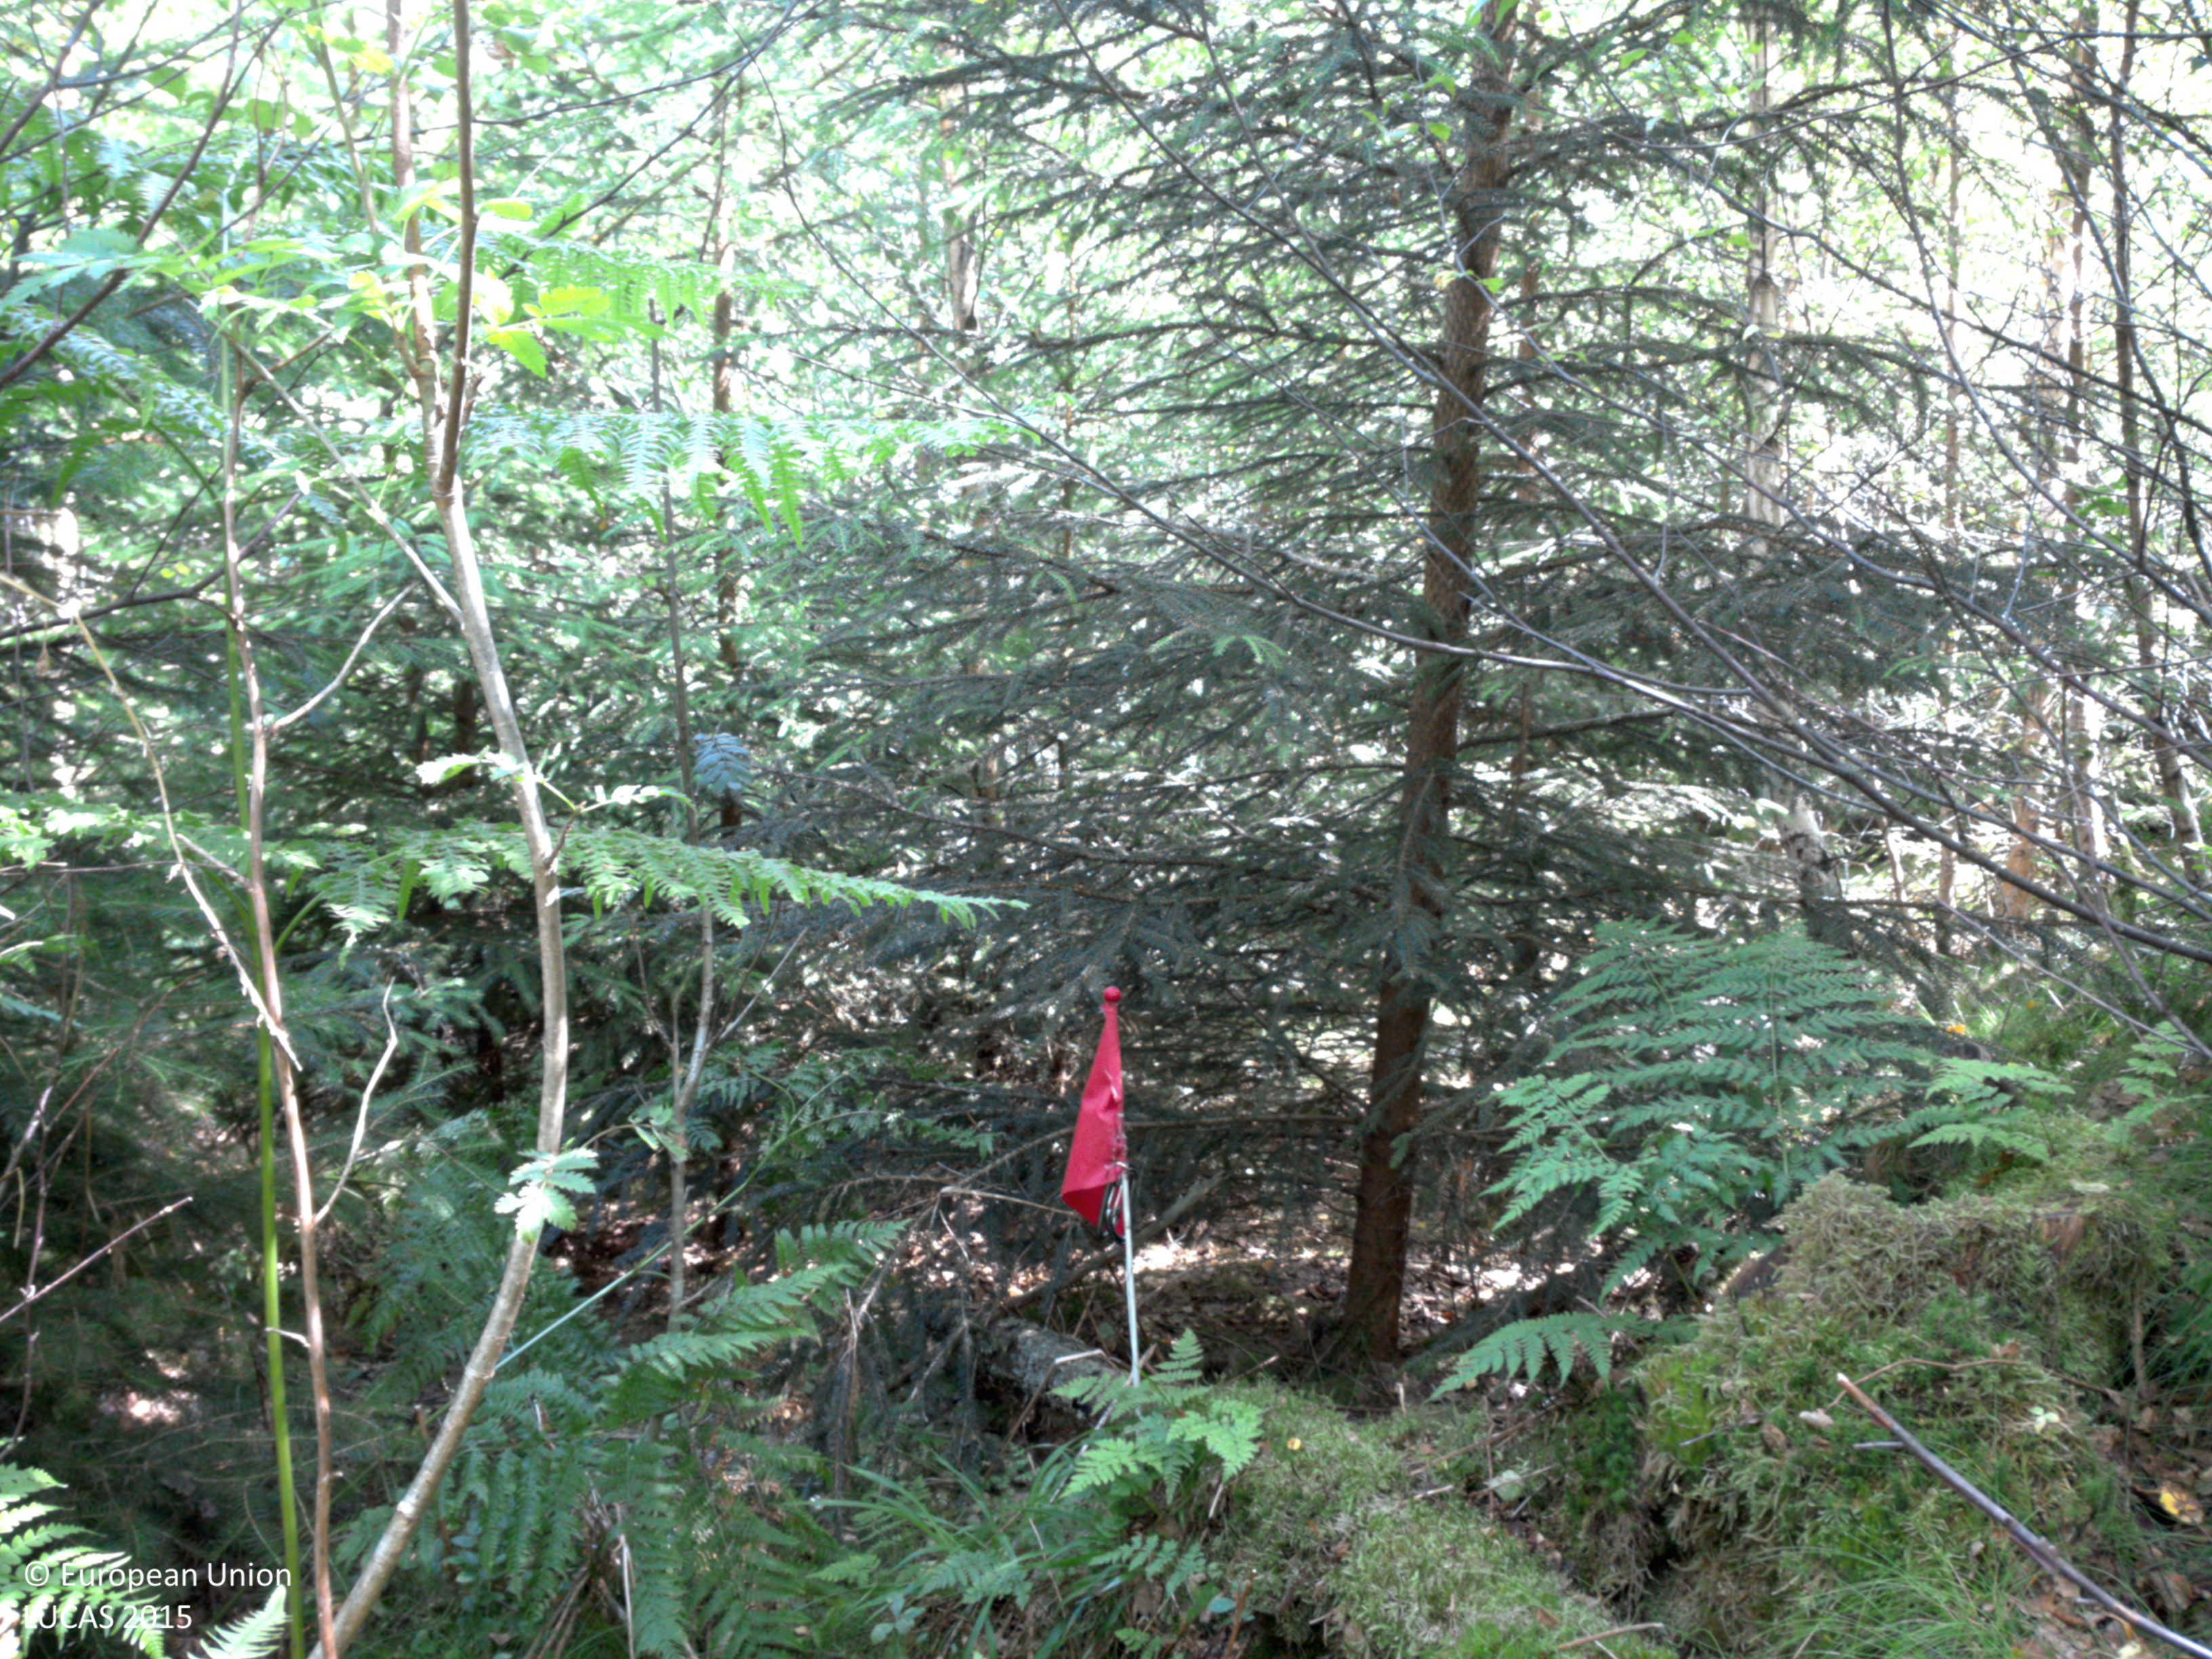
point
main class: Woodland
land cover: Spruce dominated mixed woodland
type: boreal forest
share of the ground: > 75 %
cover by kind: coniferous forest trees 60 %, broadleaved forest trees 30 %, shrubs 5 %, herbaceous plants 5 %
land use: Forestry
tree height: < 5 m
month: July
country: SE
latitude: 58.1362
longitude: 11.7460
